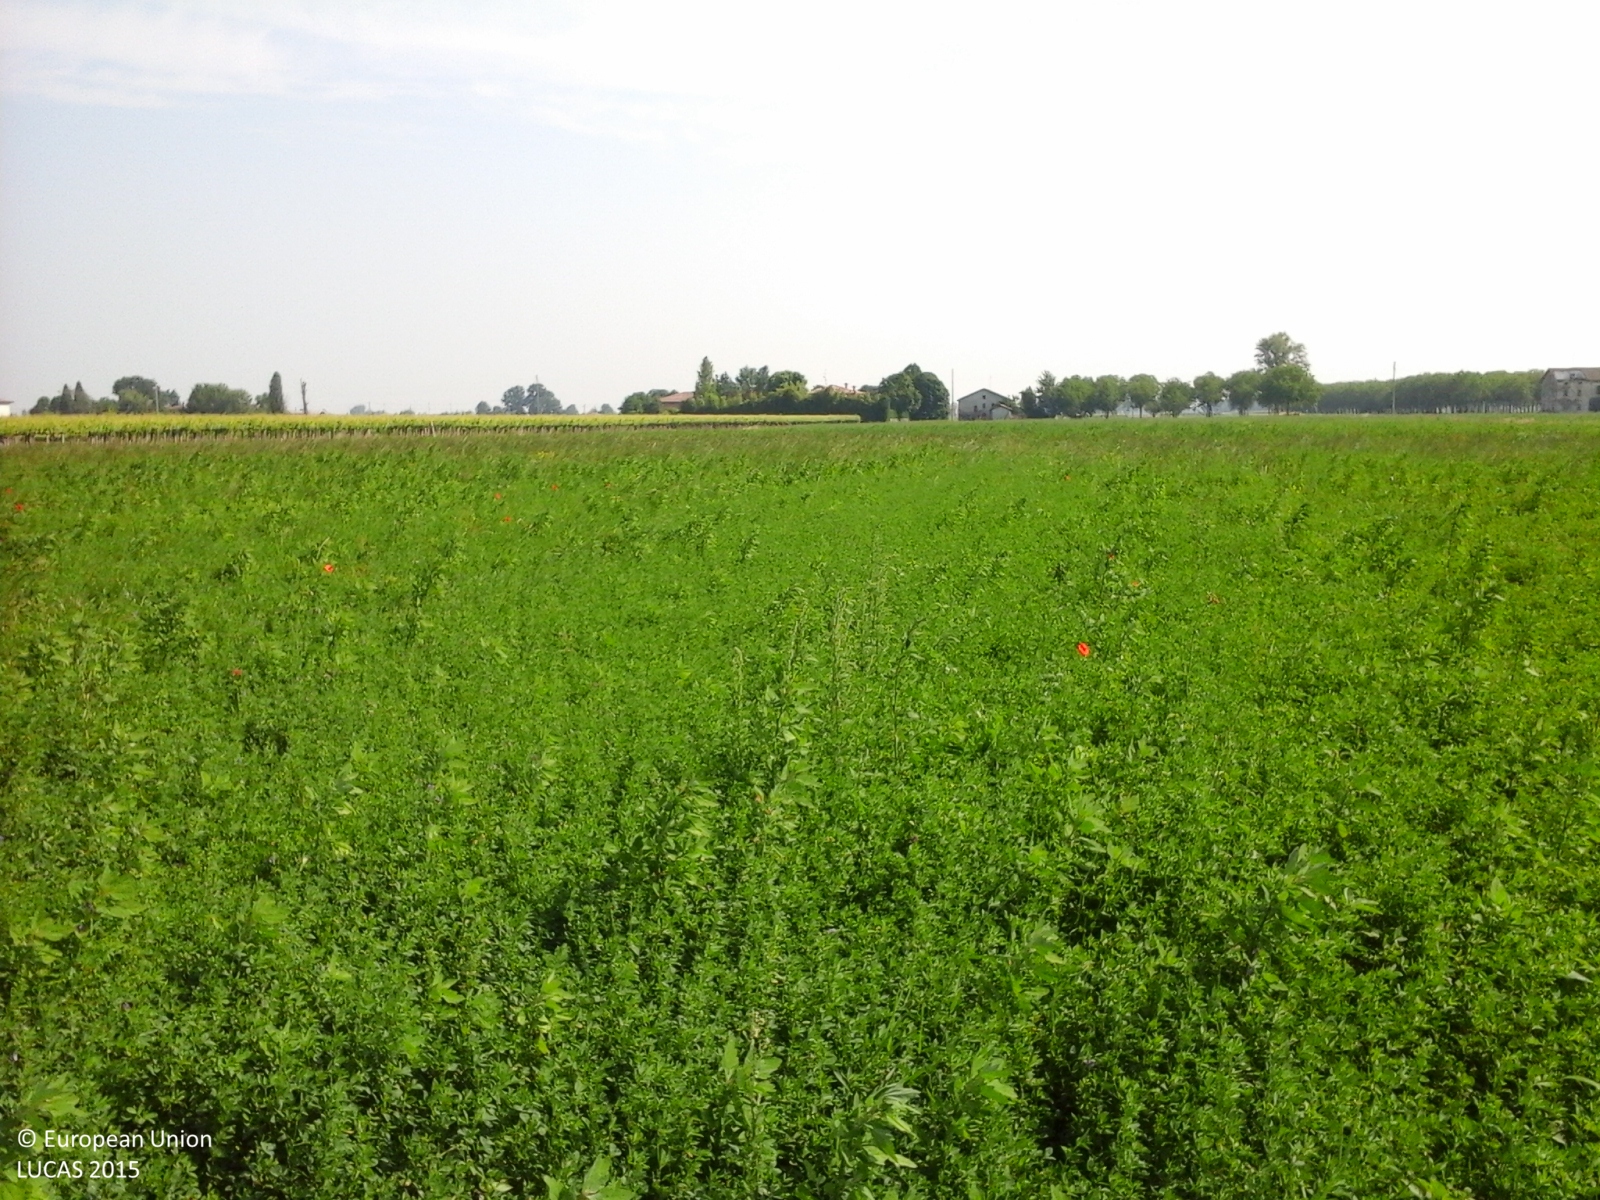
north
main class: Cropland
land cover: Lucerne
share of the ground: > 75 %
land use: Agriculture (excluding fallow land and kitchen gardens)
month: May
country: IT
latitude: 44.7082
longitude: 10.7935
